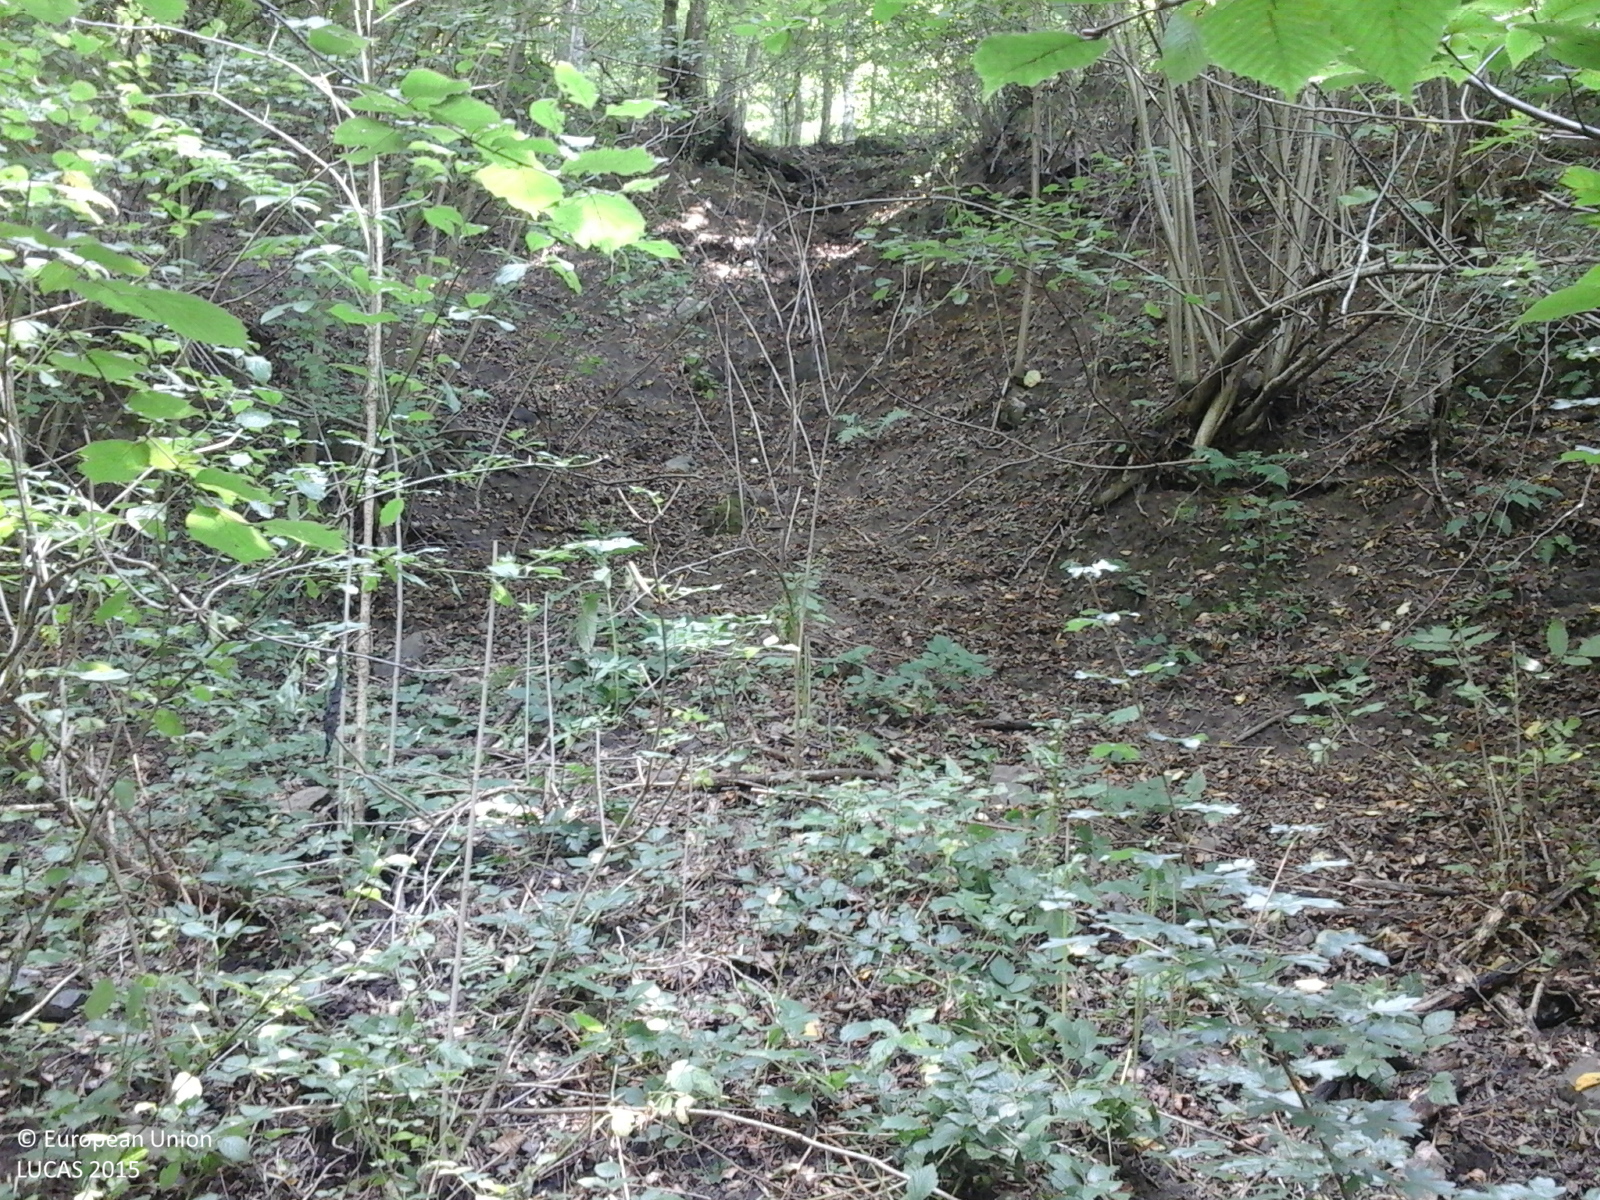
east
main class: Woodland
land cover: Broadleaved woodland
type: broadleaved evergreen forest
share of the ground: > 75 %
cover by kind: broadleaved forest trees 100 %
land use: Forestry
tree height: > 5 m
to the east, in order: Broadleaved woodland
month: August
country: RO
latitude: 46.2919
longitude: 22.4725
